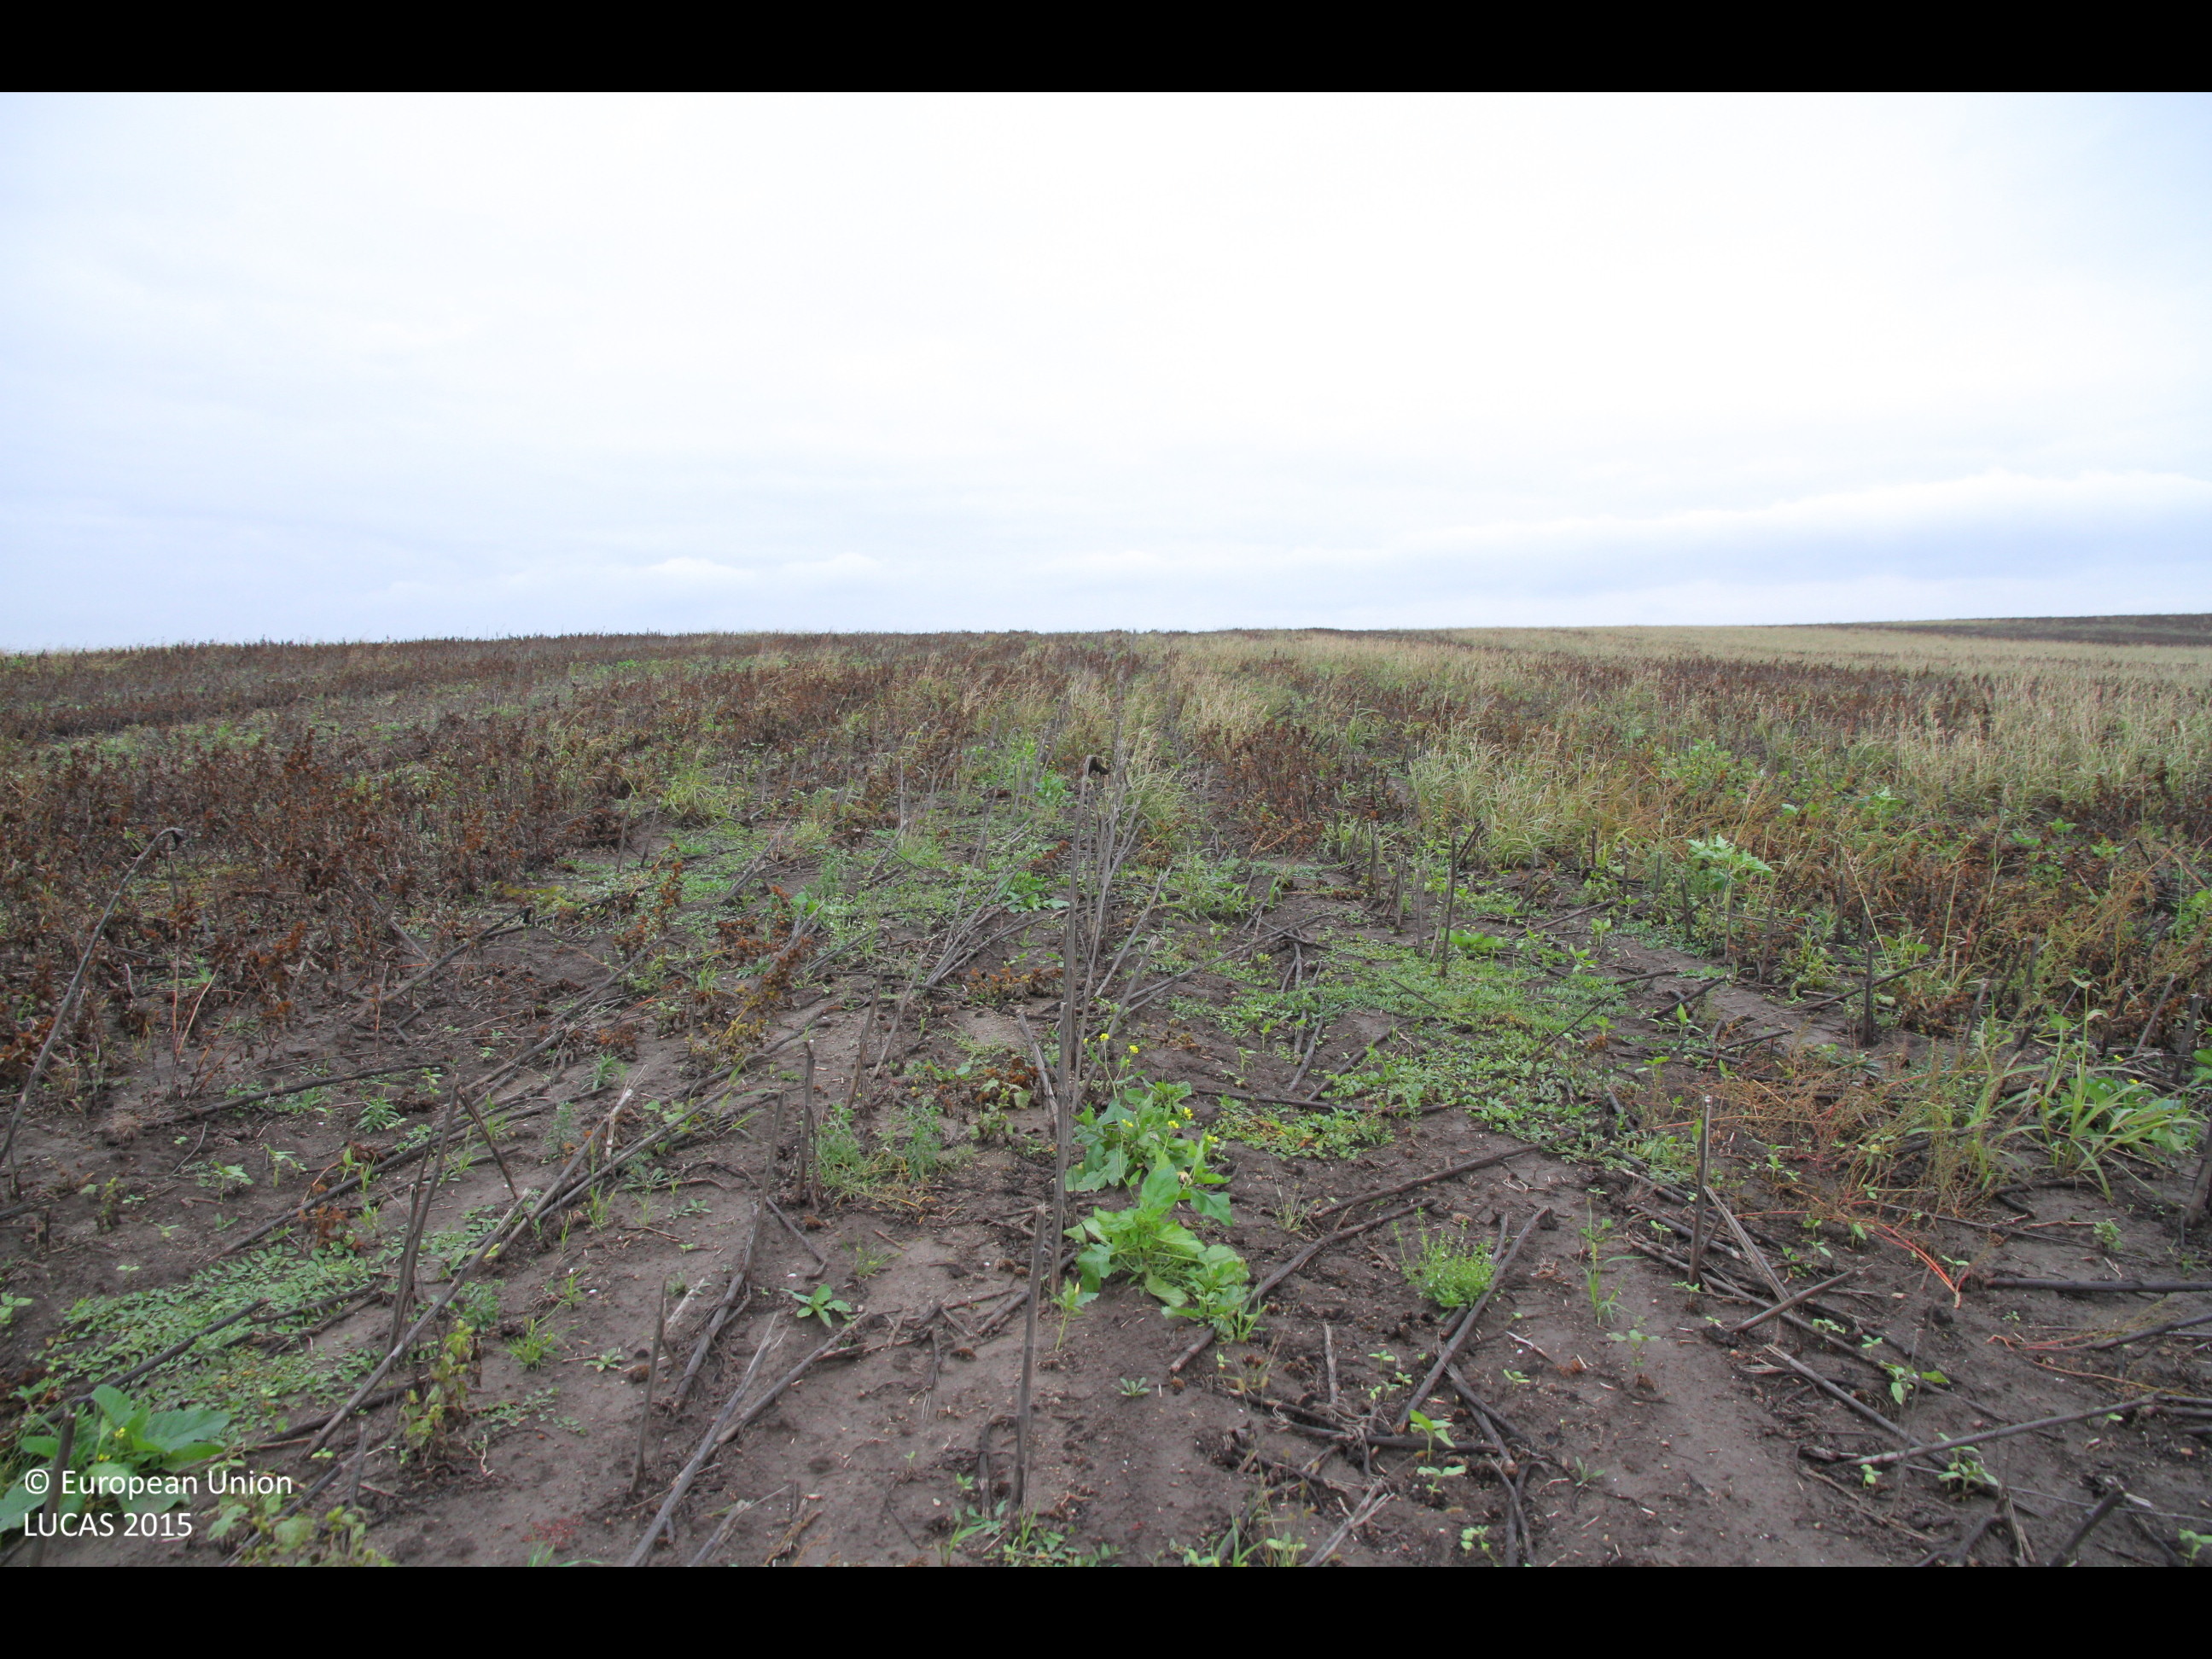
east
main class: Cropland
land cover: Sunflower
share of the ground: < 10 %
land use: Agriculture (excluding fallow land and kitchen gardens)
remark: Harvested field
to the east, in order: Sunflower
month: October
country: BG
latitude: 43.4396
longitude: 26.9556
